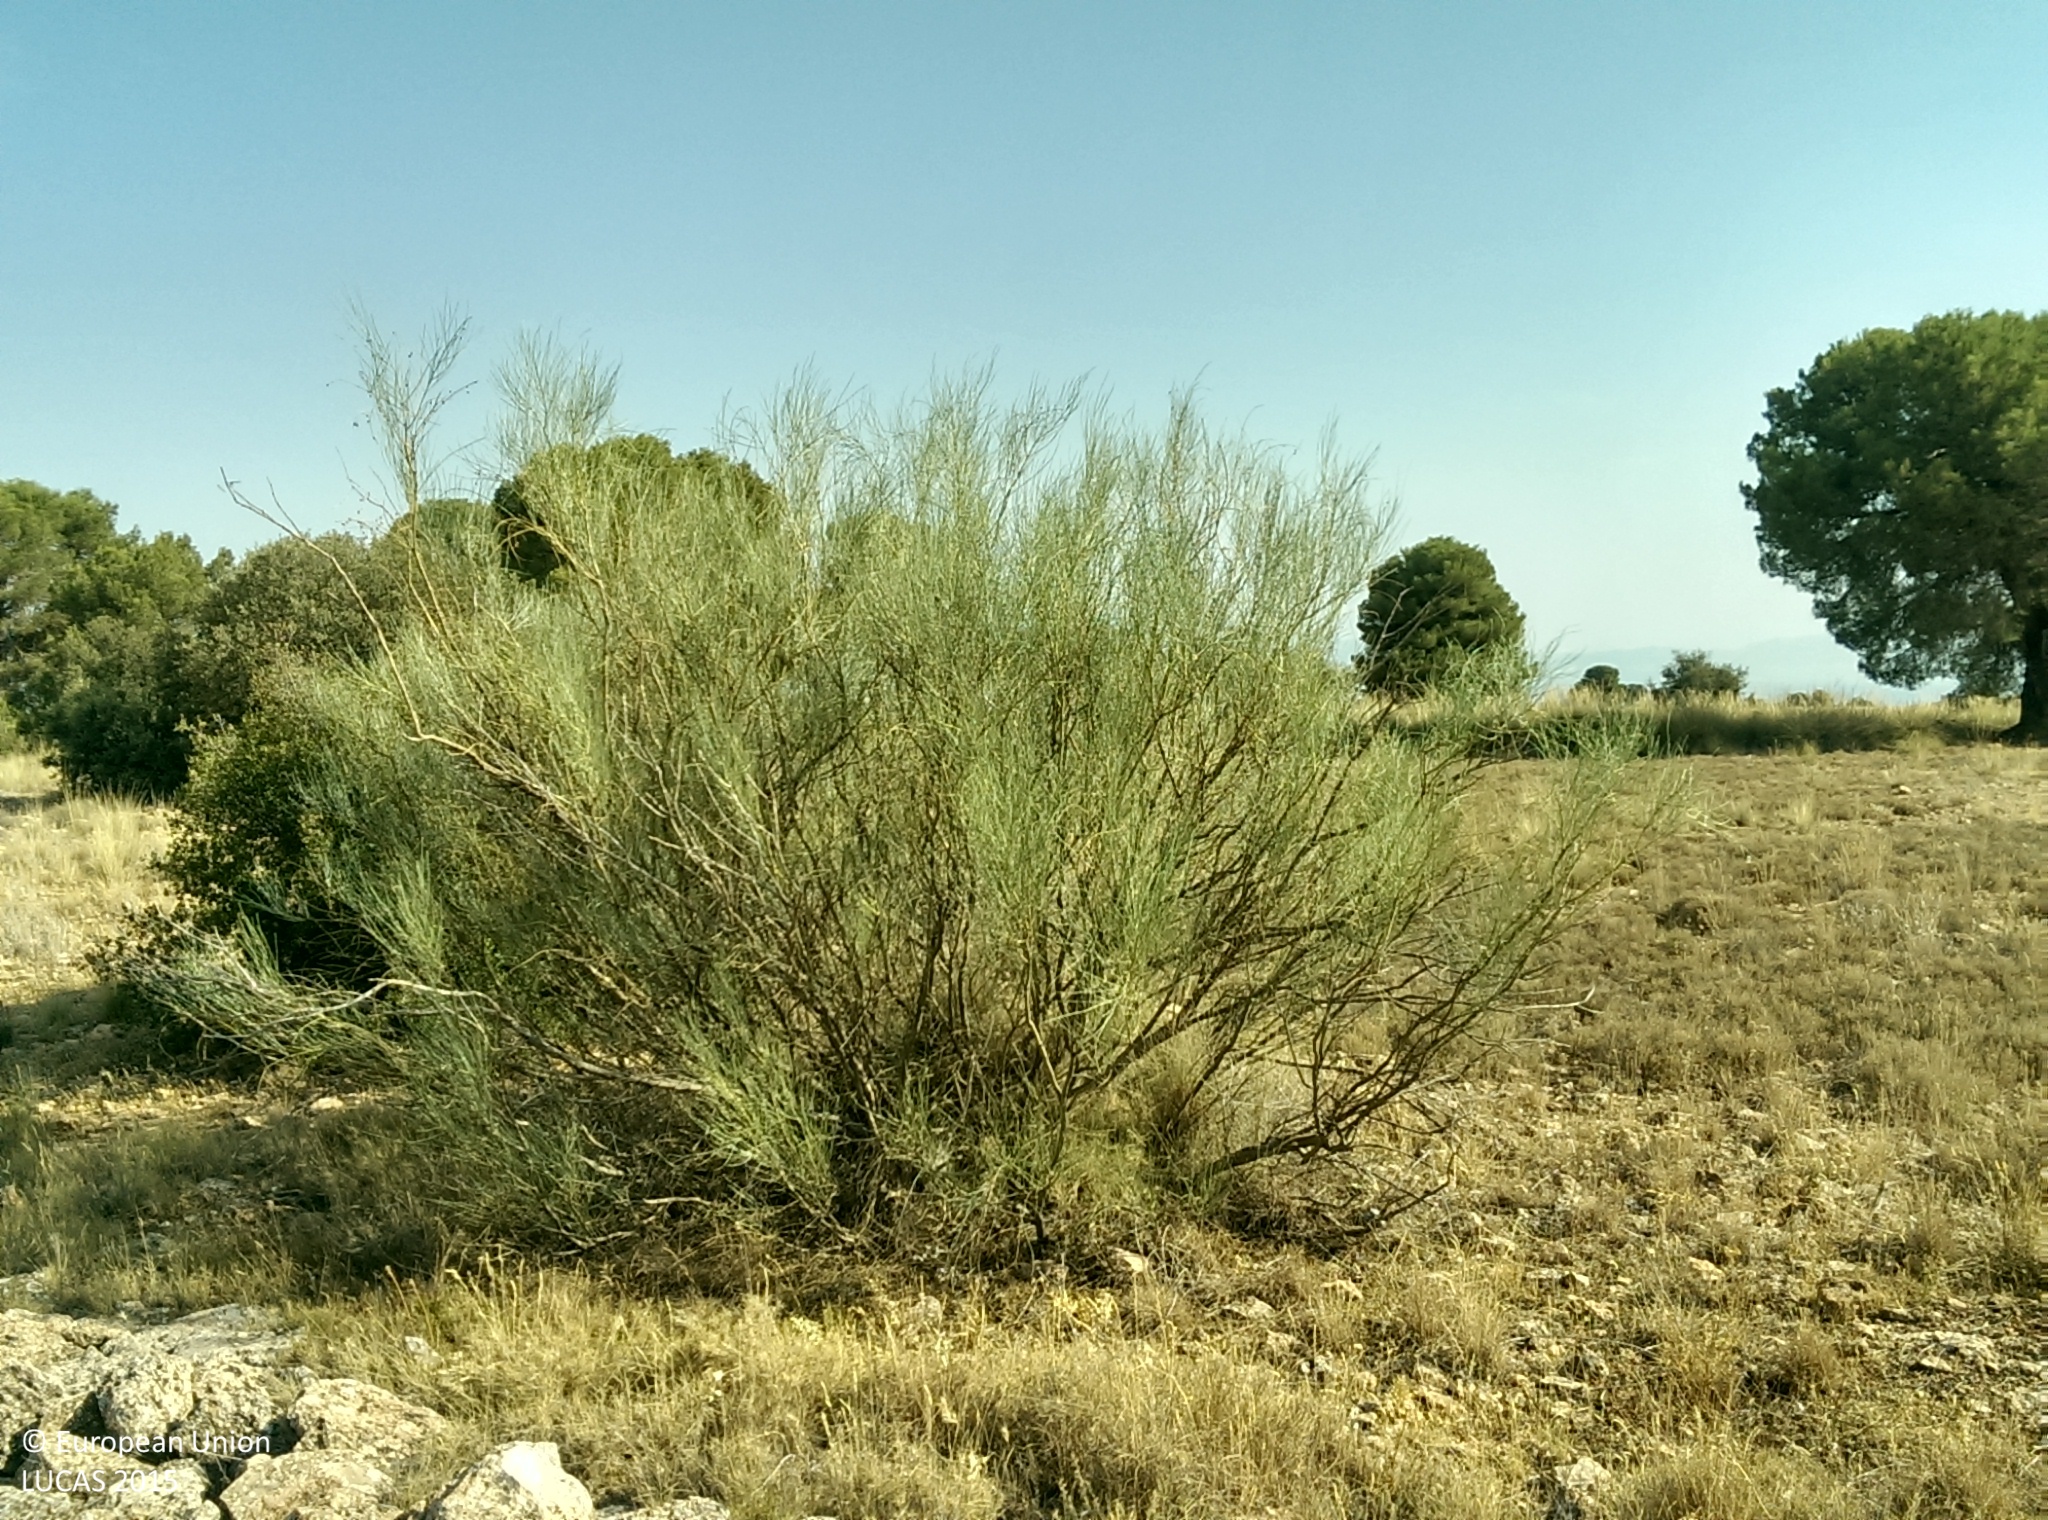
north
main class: Grassland
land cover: Grassland with sparse tree/shrub cover
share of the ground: > 75 %
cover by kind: herbaceous plants 80 %, consolidated bare surface 10 %, broadleaved forest trees 5 %, shrubs 5 %
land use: Semi-natural and natural areas not in use
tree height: < 5 m
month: July
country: ES
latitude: 37.4625
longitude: -2.9559
